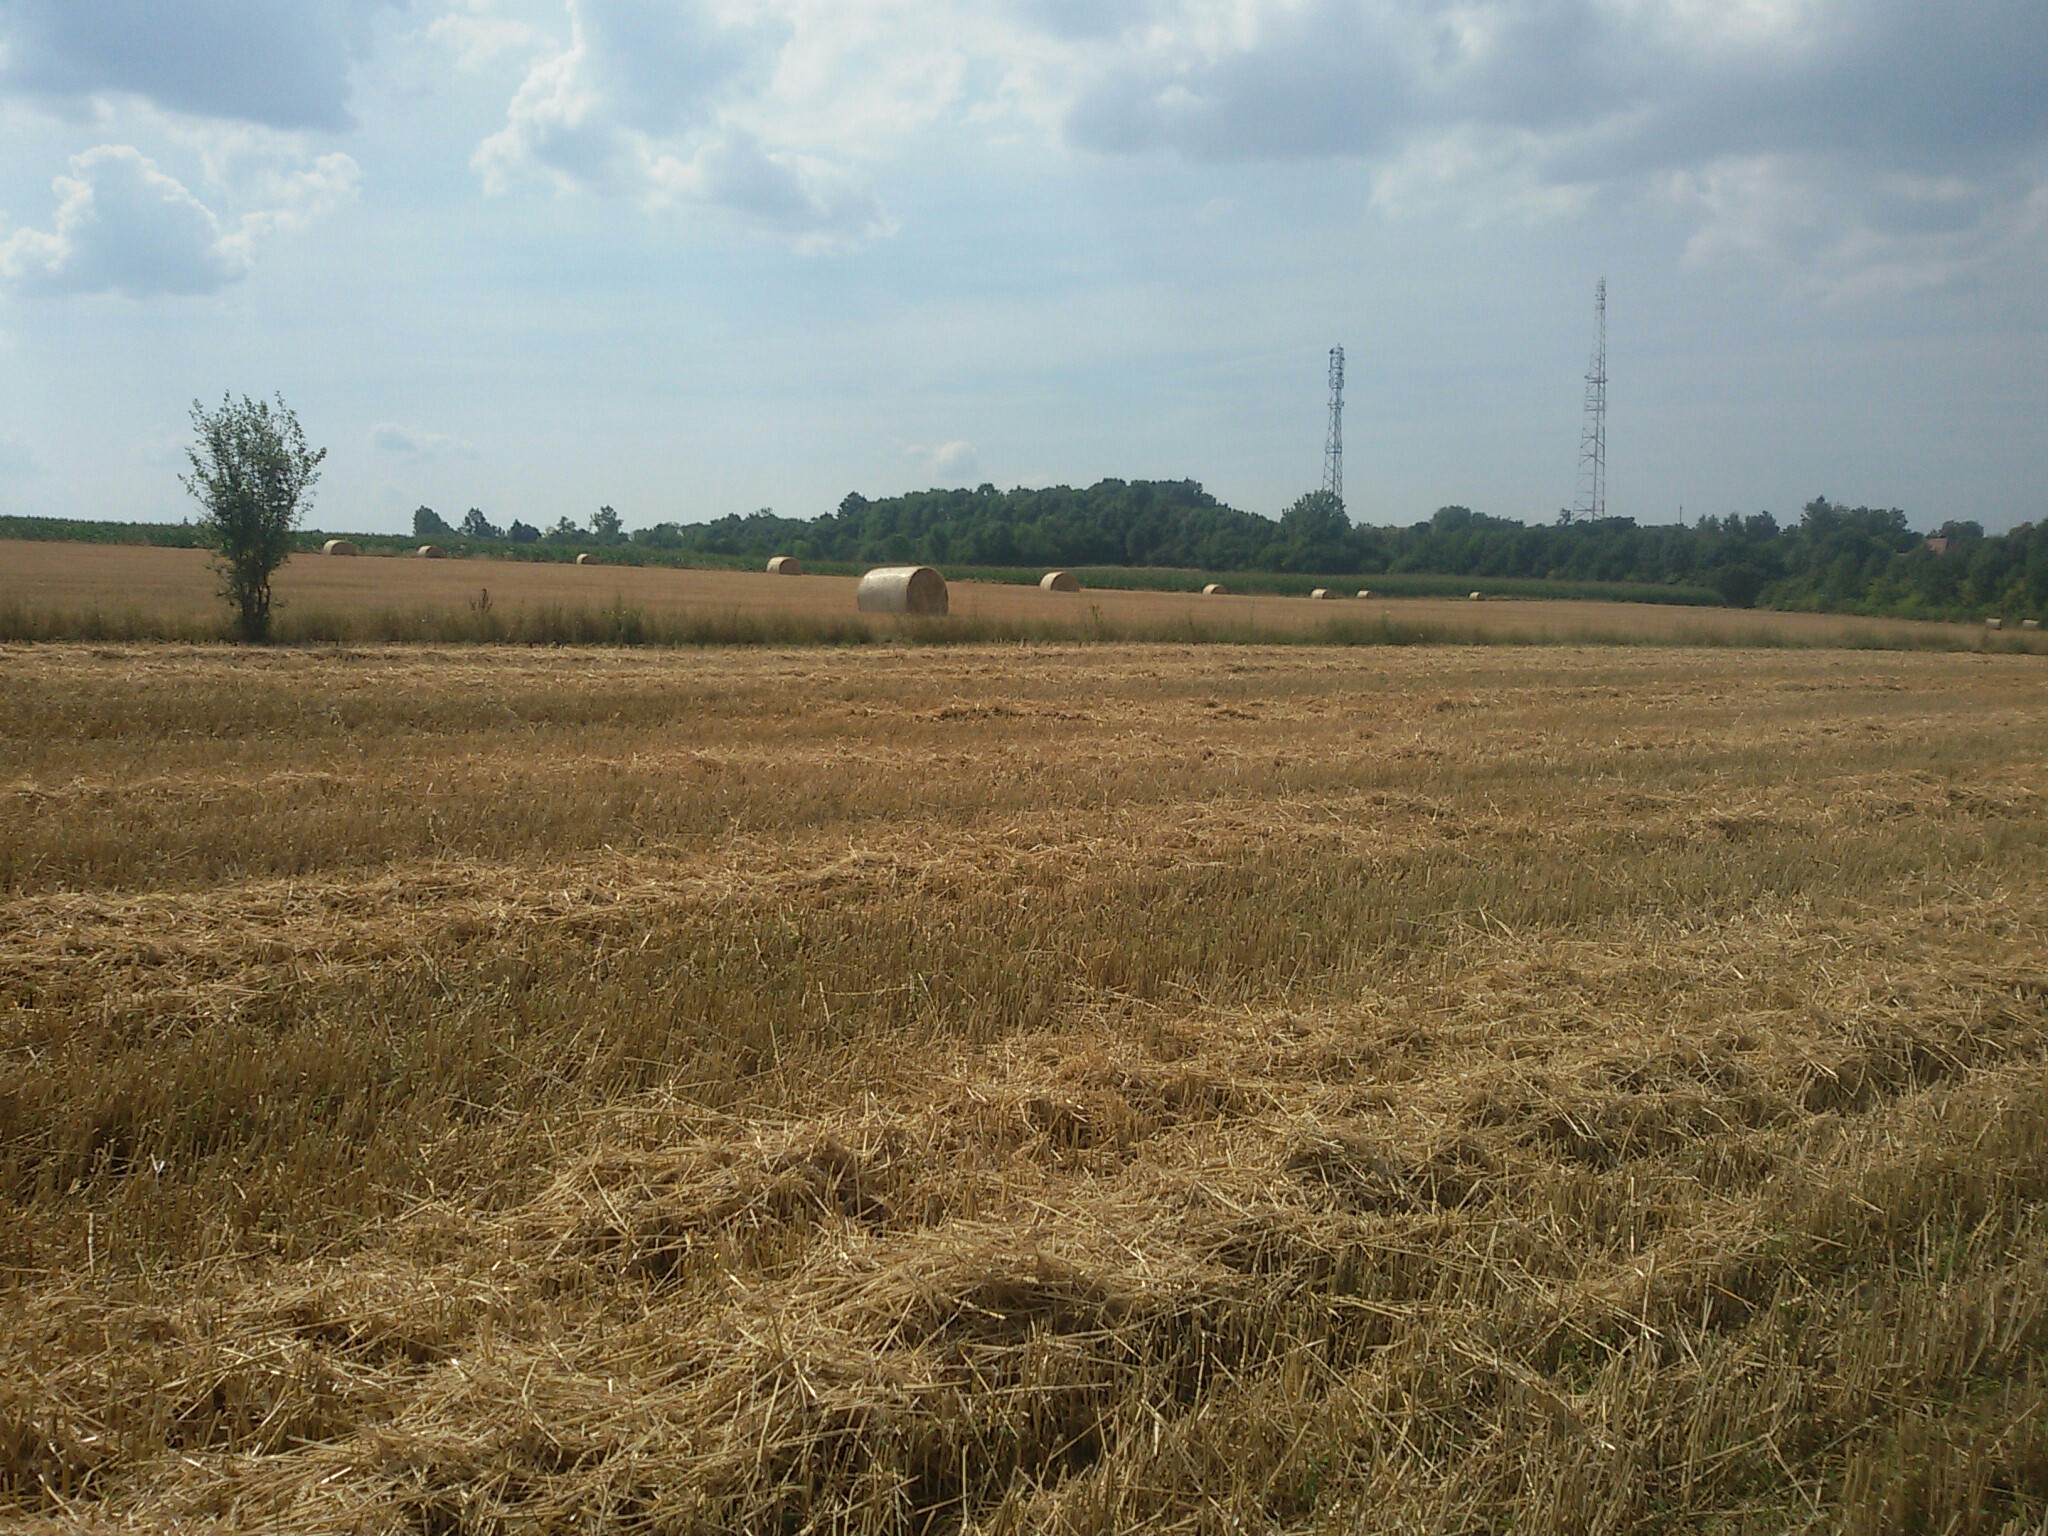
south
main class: Cropland
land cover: Common wheat
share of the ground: > 75 %
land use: Agriculture (excluding fallow land and kitchen gardens)
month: August
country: PL
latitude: 51.0802
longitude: 15.4712
